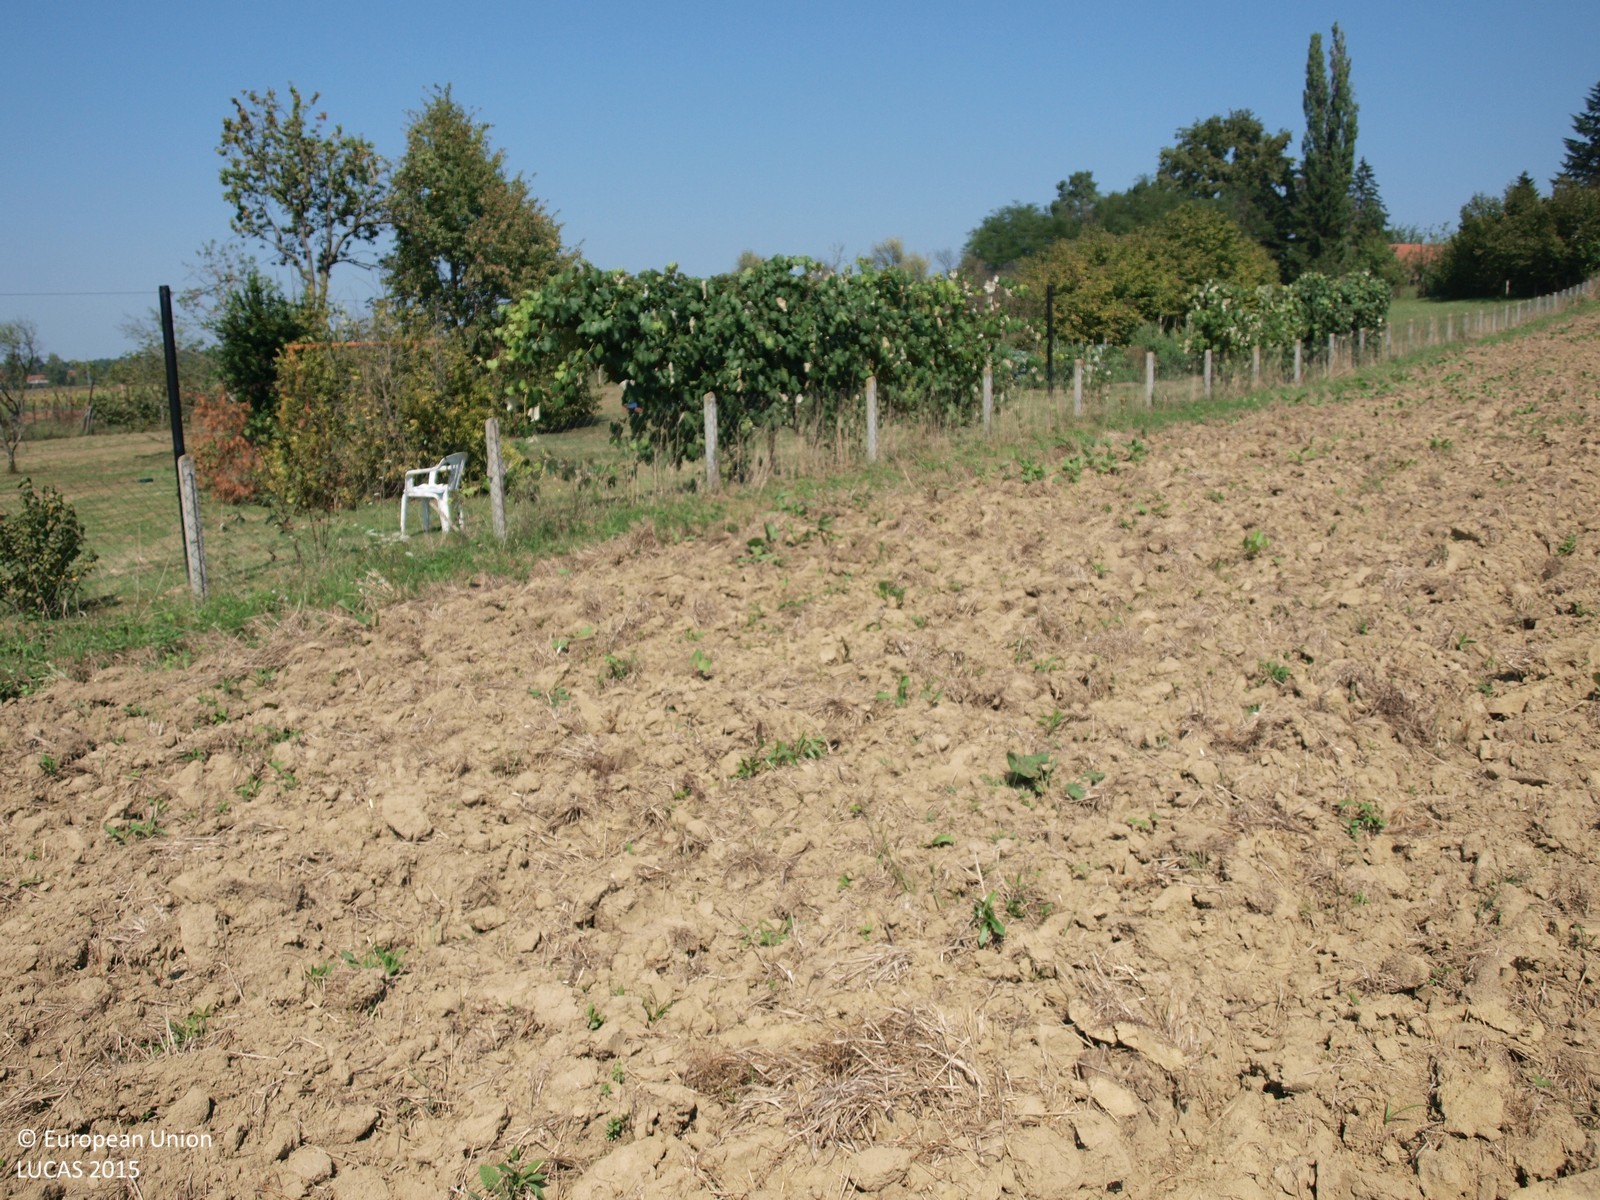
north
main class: Cropland
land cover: Common wheat
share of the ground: > 75 %
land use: Agriculture (excluding fallow land and kitchen gardens)
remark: Harvested field
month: August
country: HR
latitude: 45.7026
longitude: 16.4849
